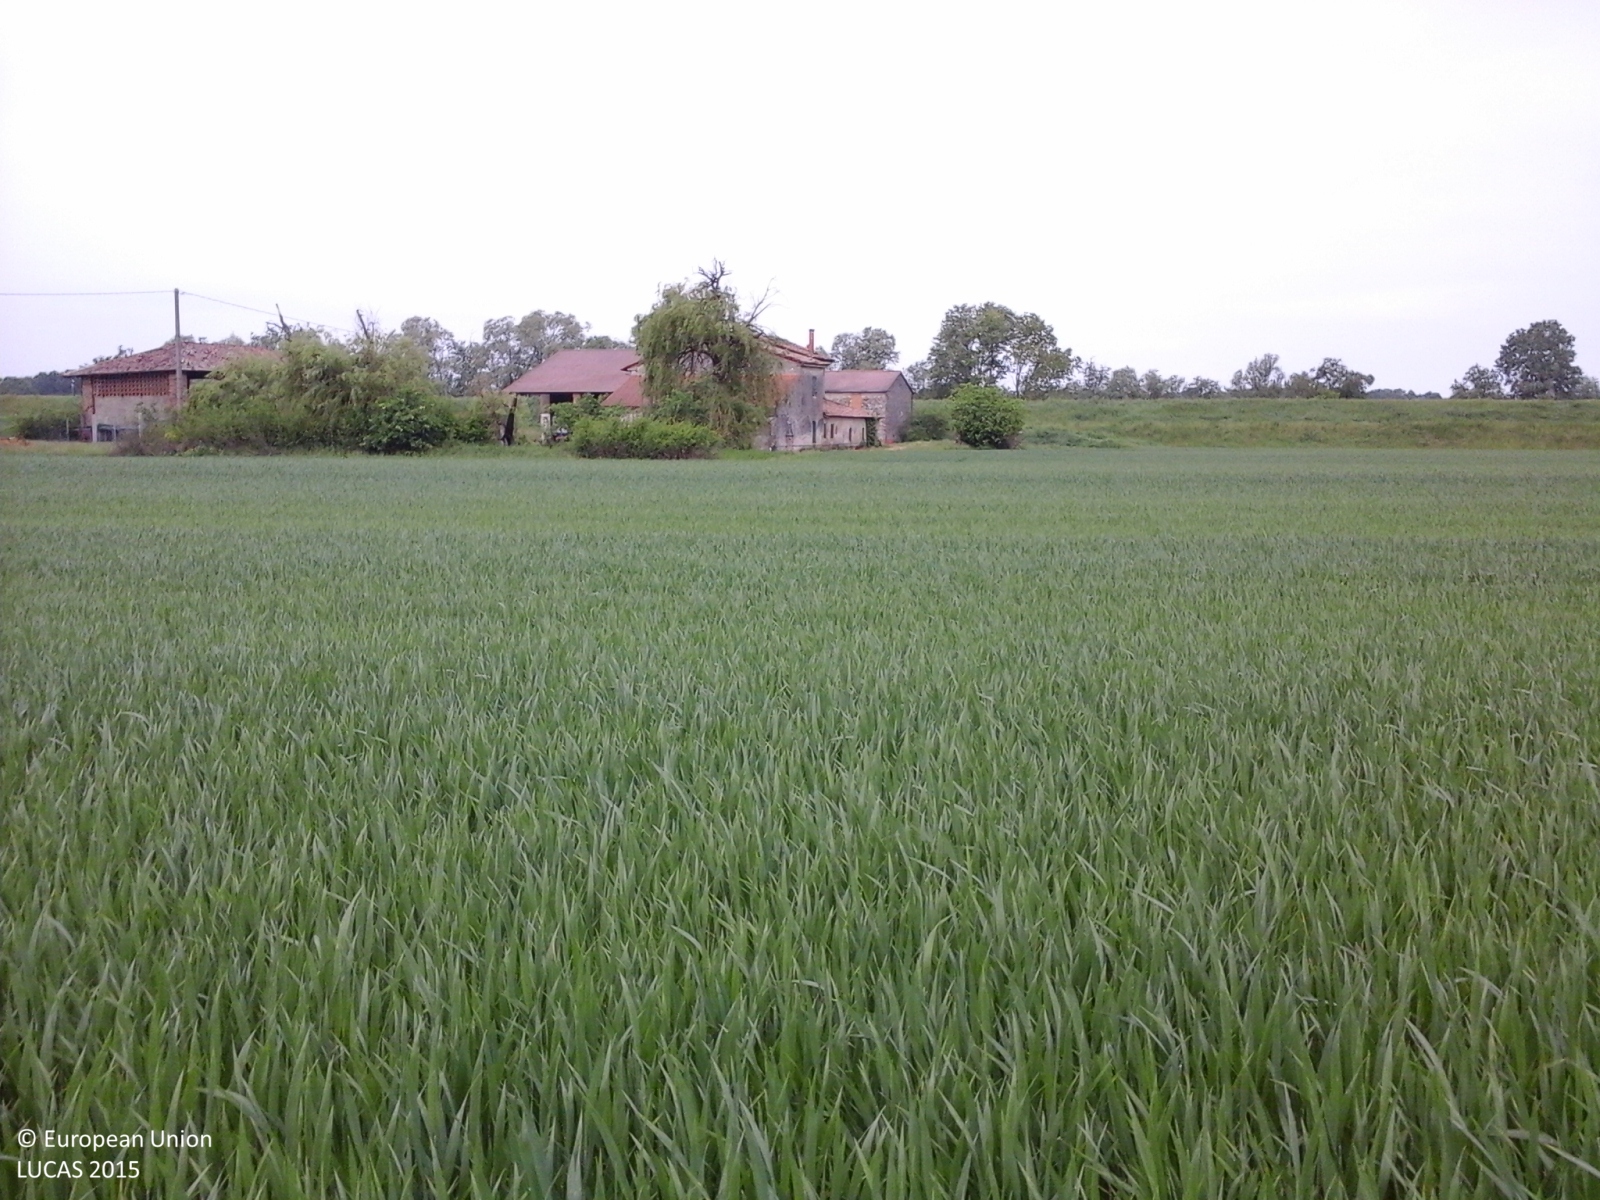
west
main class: Cropland
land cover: Common wheat
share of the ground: > 75 %
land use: Agriculture (excluding fallow land and kitchen gardens)
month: April
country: IT
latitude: 45.0889
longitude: 9.5562
